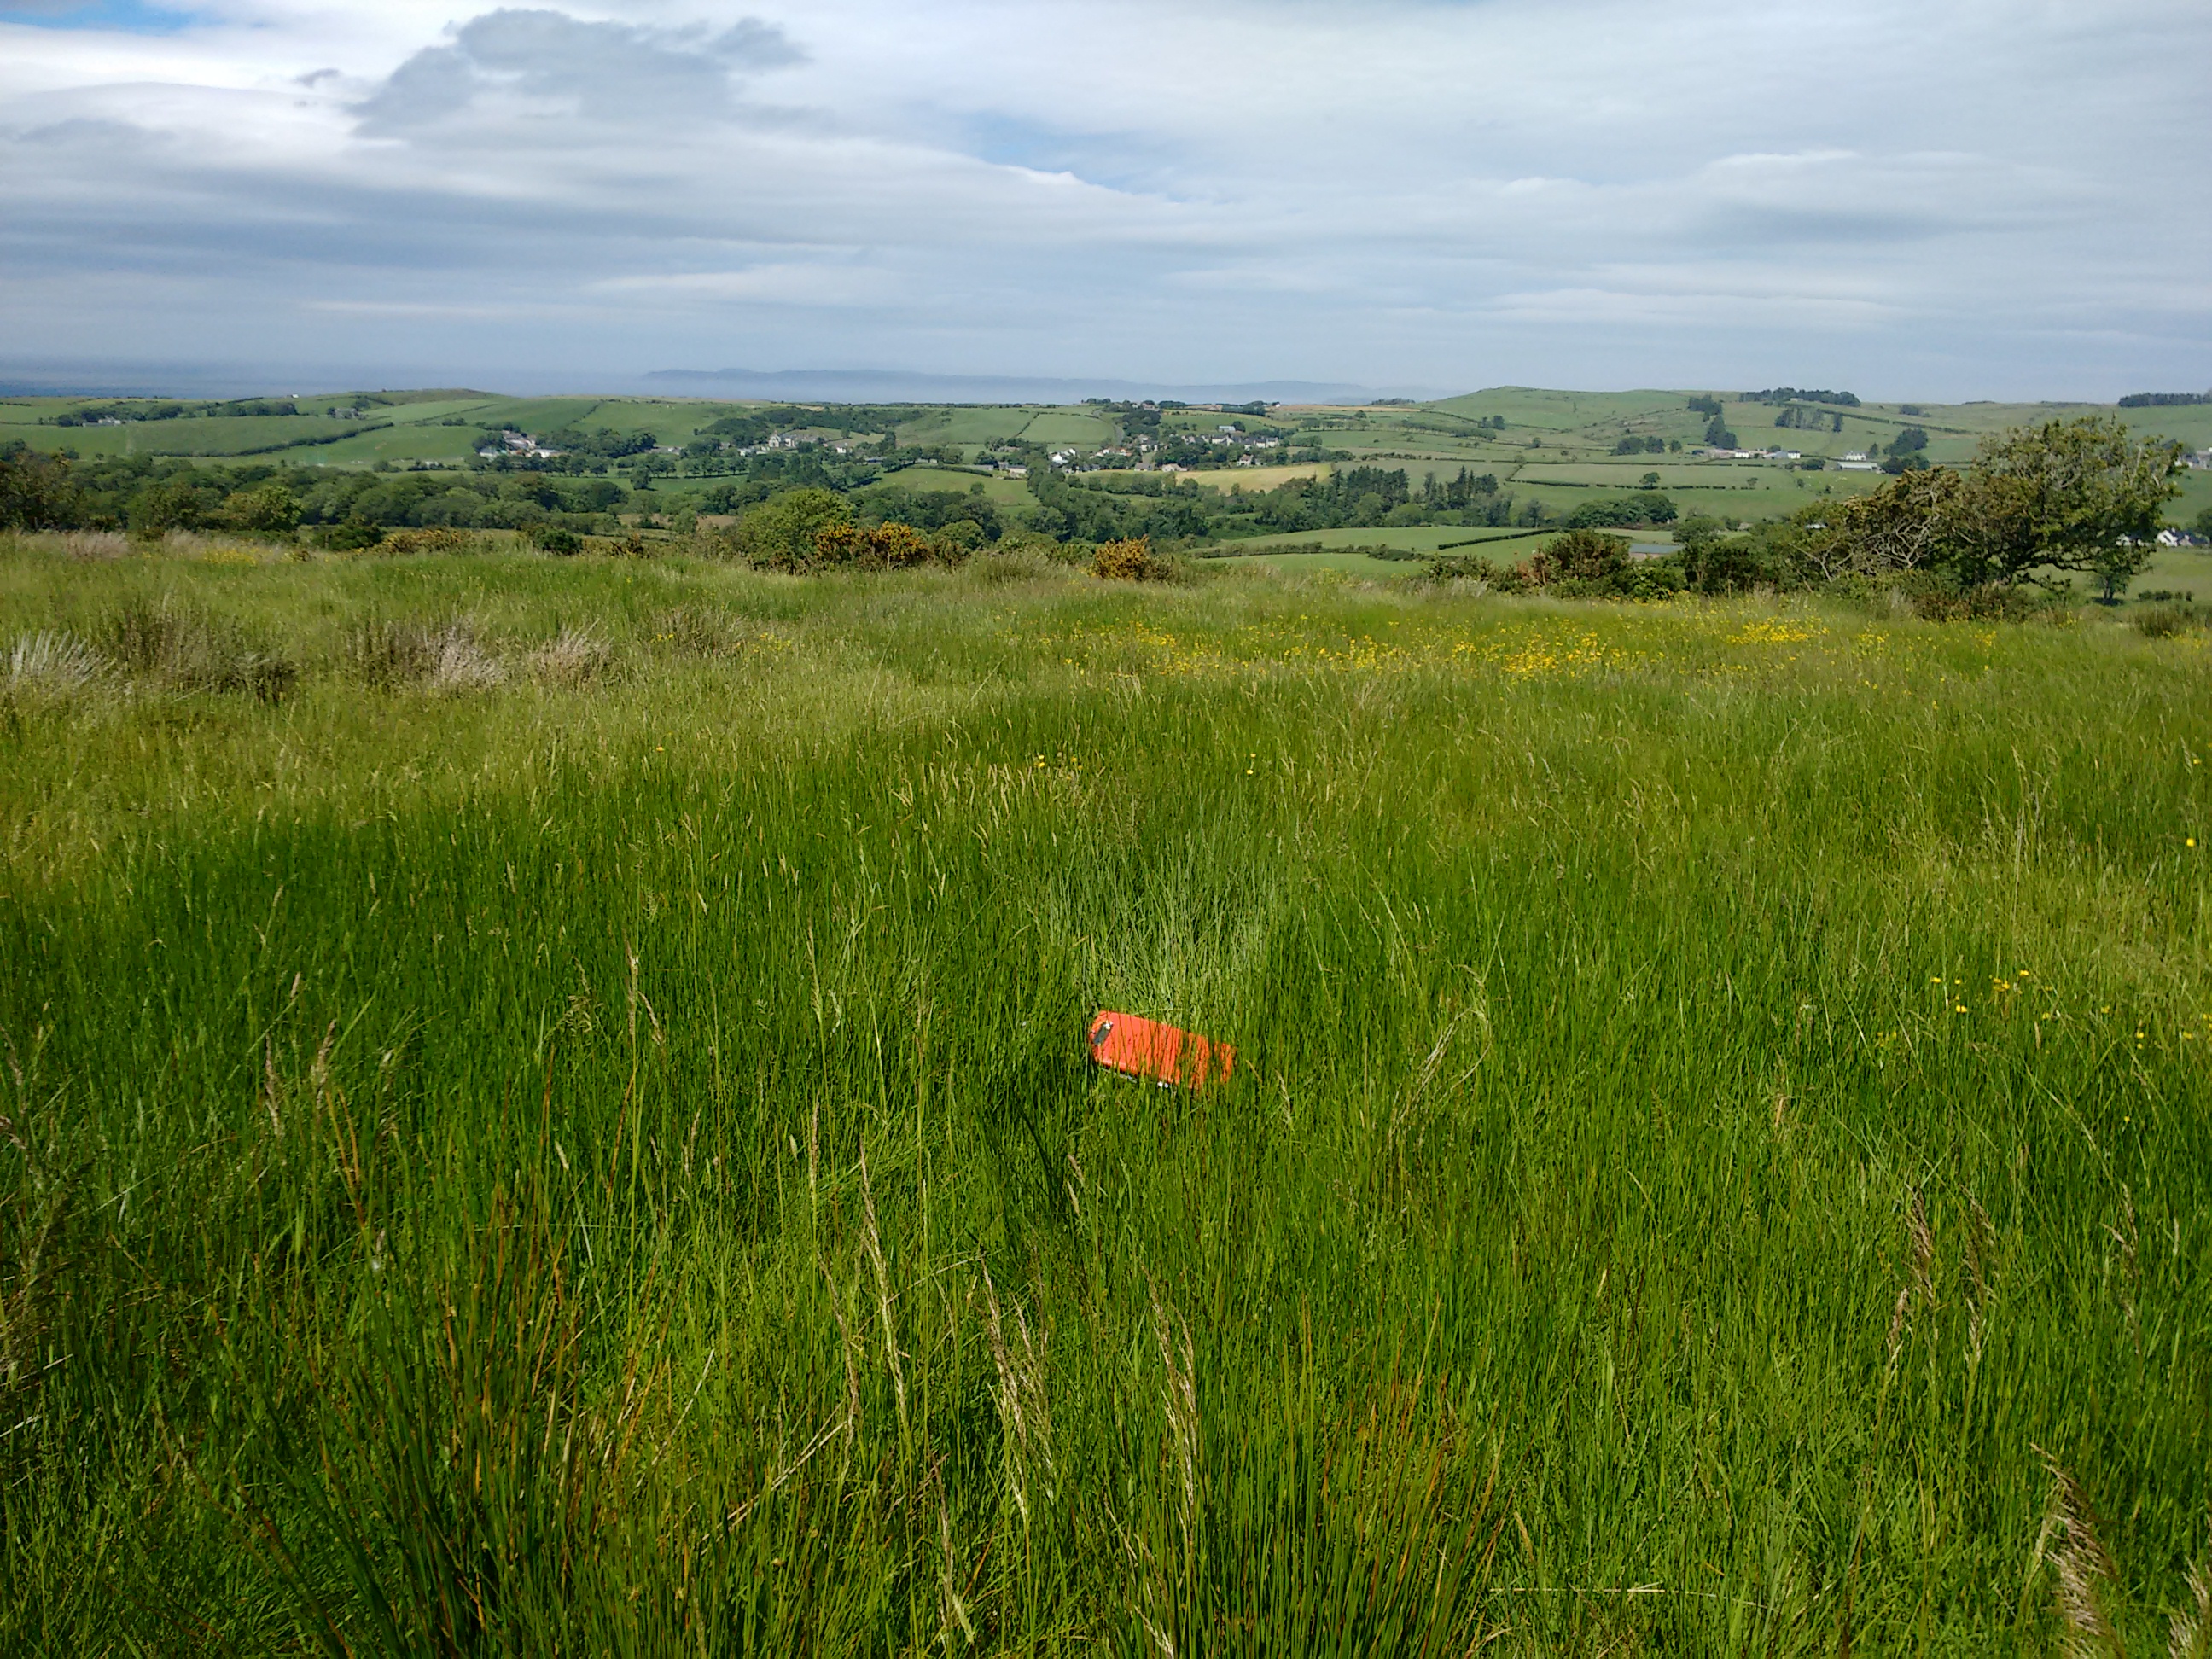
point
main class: Grassland
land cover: Grassland without tree/shrub cover
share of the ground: > 75 %
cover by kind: herbaceous plants 100 %
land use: Agriculture (excluding fallow land and kitchen gardens)
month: June
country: GB
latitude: 55.1873
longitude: -6.1801
